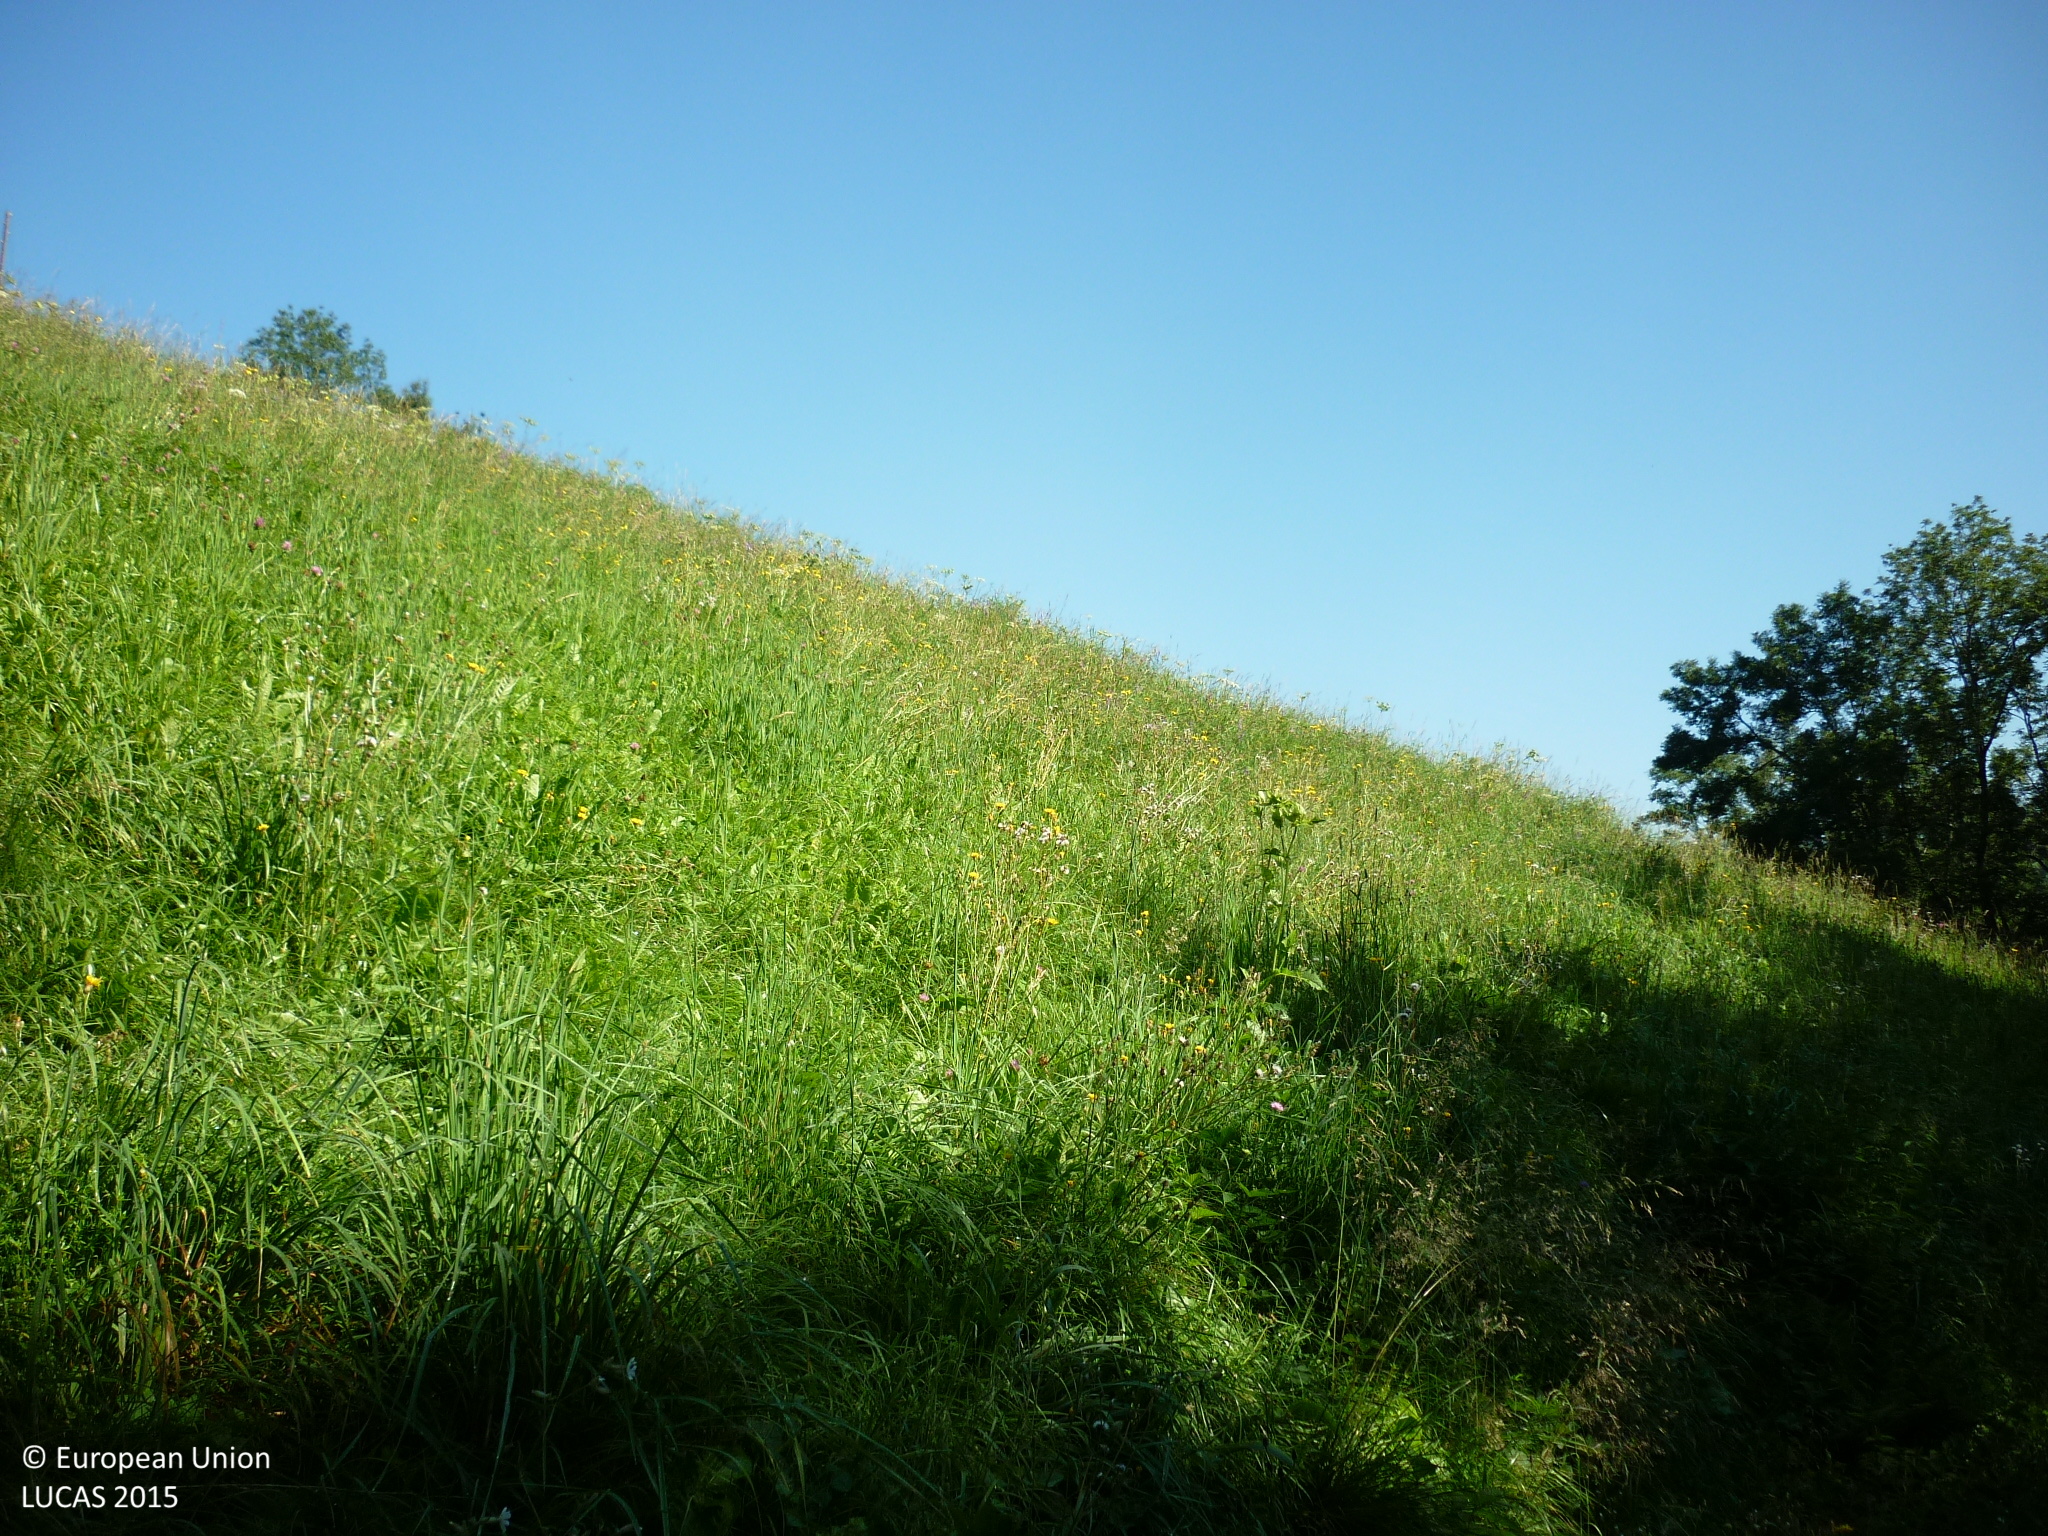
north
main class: Grassland
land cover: Grassland without tree/shrub cover
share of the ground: > 75 %
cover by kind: herbaceous plants 100 %
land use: Agriculture (excluding fallow land and kitchen gardens)
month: August
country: AT
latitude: 46.9042
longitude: 13.5815
